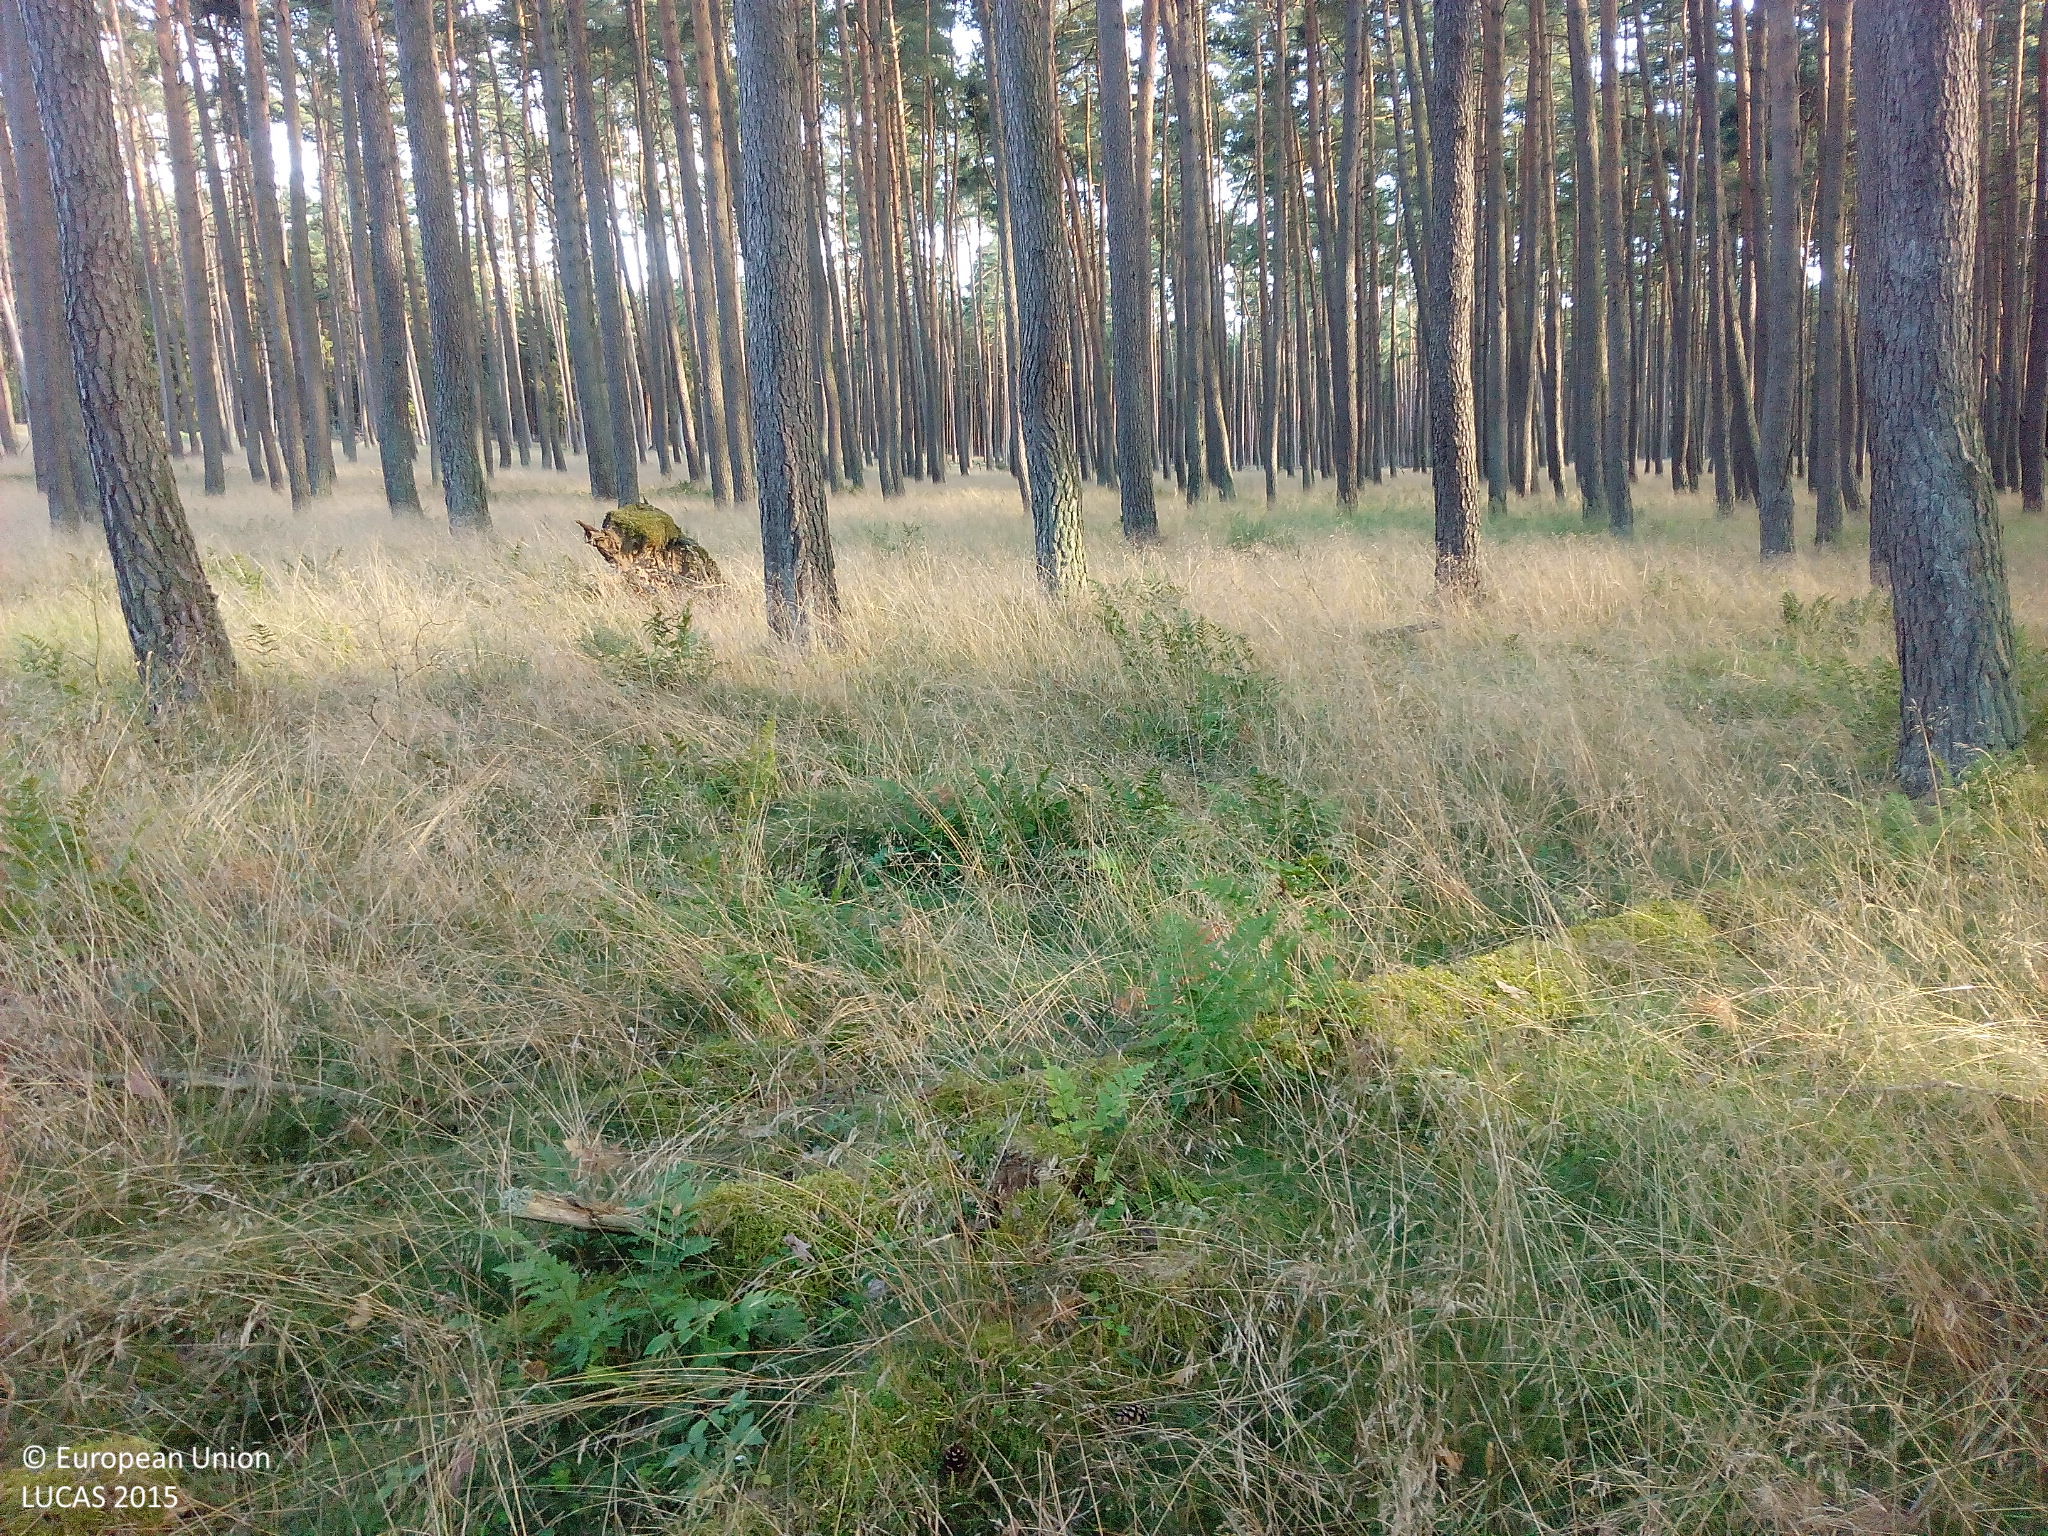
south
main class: Woodland
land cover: Pine dominated coniferous woodland
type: hemiboreal forest and nemoral coniferous forest and mixed broadleaved-coniferous forest
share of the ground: > 75 %
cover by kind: coniferous forest trees 75 %, herbaceous plants 25 %
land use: Forestry
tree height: > 5 m
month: August
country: DE
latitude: 53.5586
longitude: 12.3694
